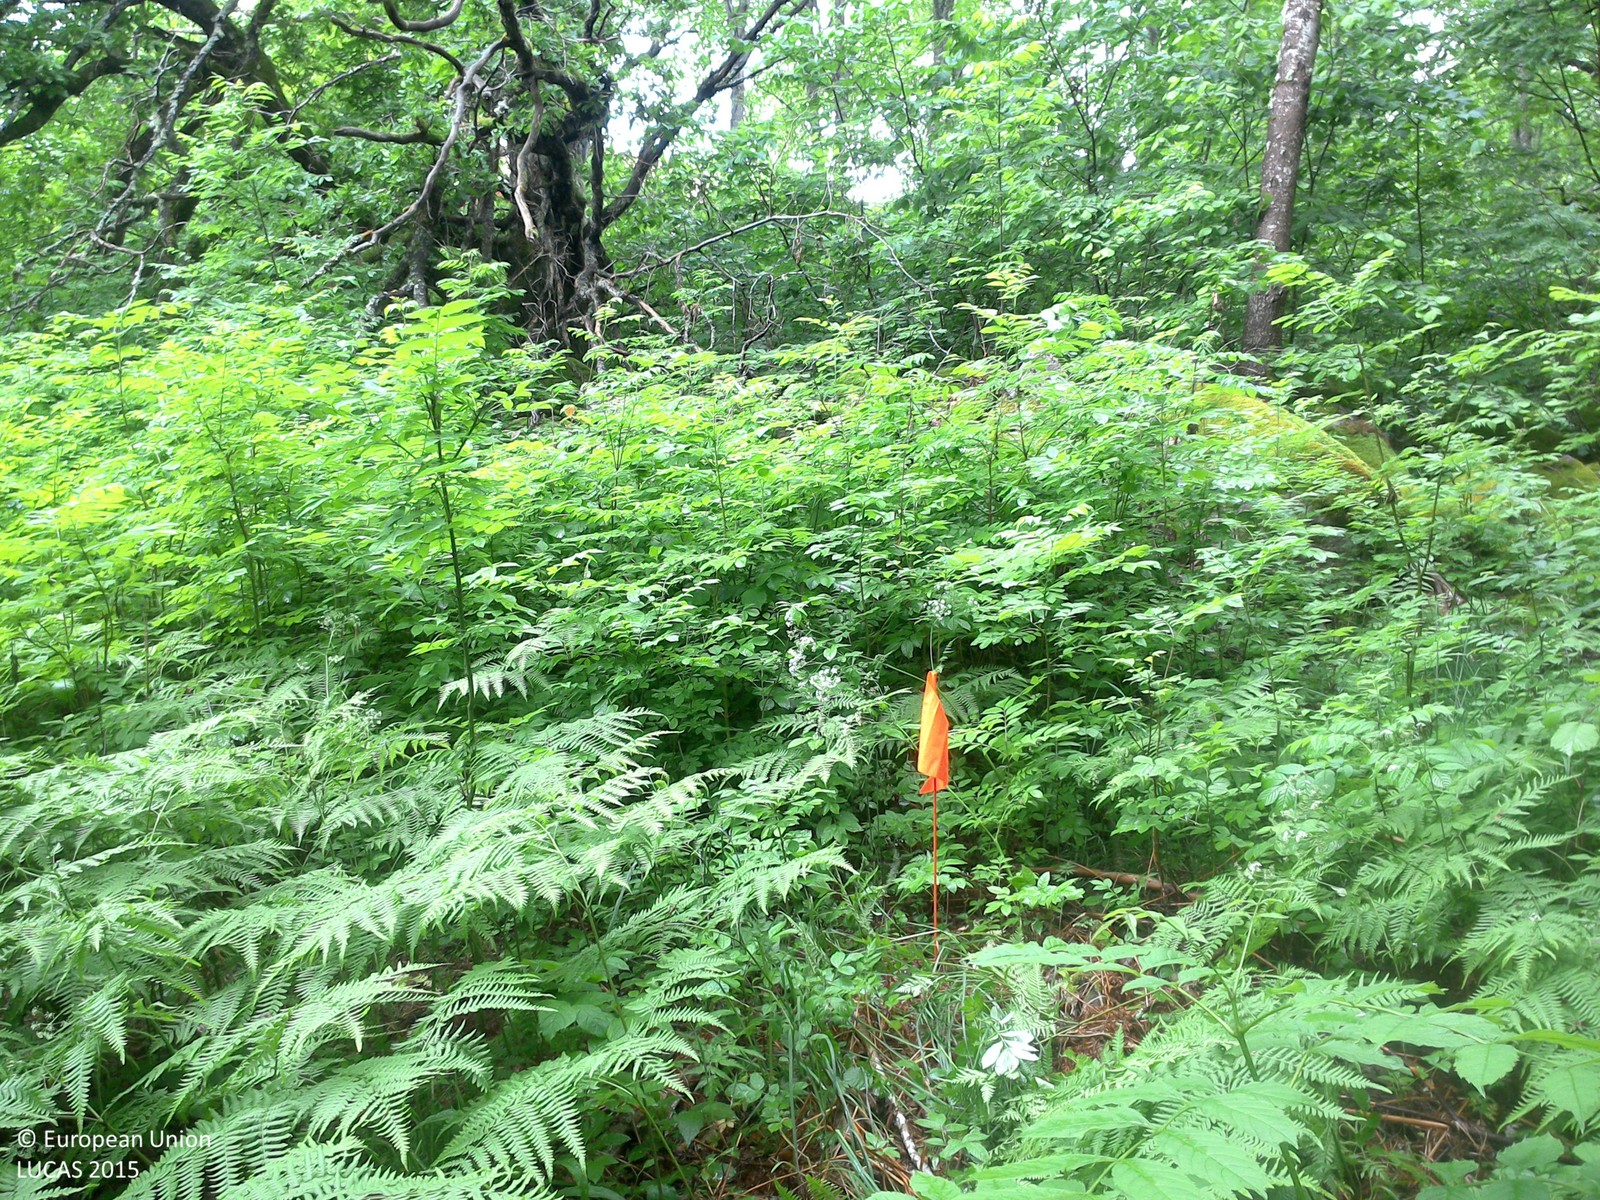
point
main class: Woodland
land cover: Broadleaved woodland
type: boreal forest
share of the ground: > 75 %
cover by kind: broadleaved forest trees 75 %, herbaceous plants 25 %
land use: Forestry
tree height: > 5 m
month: June
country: SE
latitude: 58.0665
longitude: 15.6062
